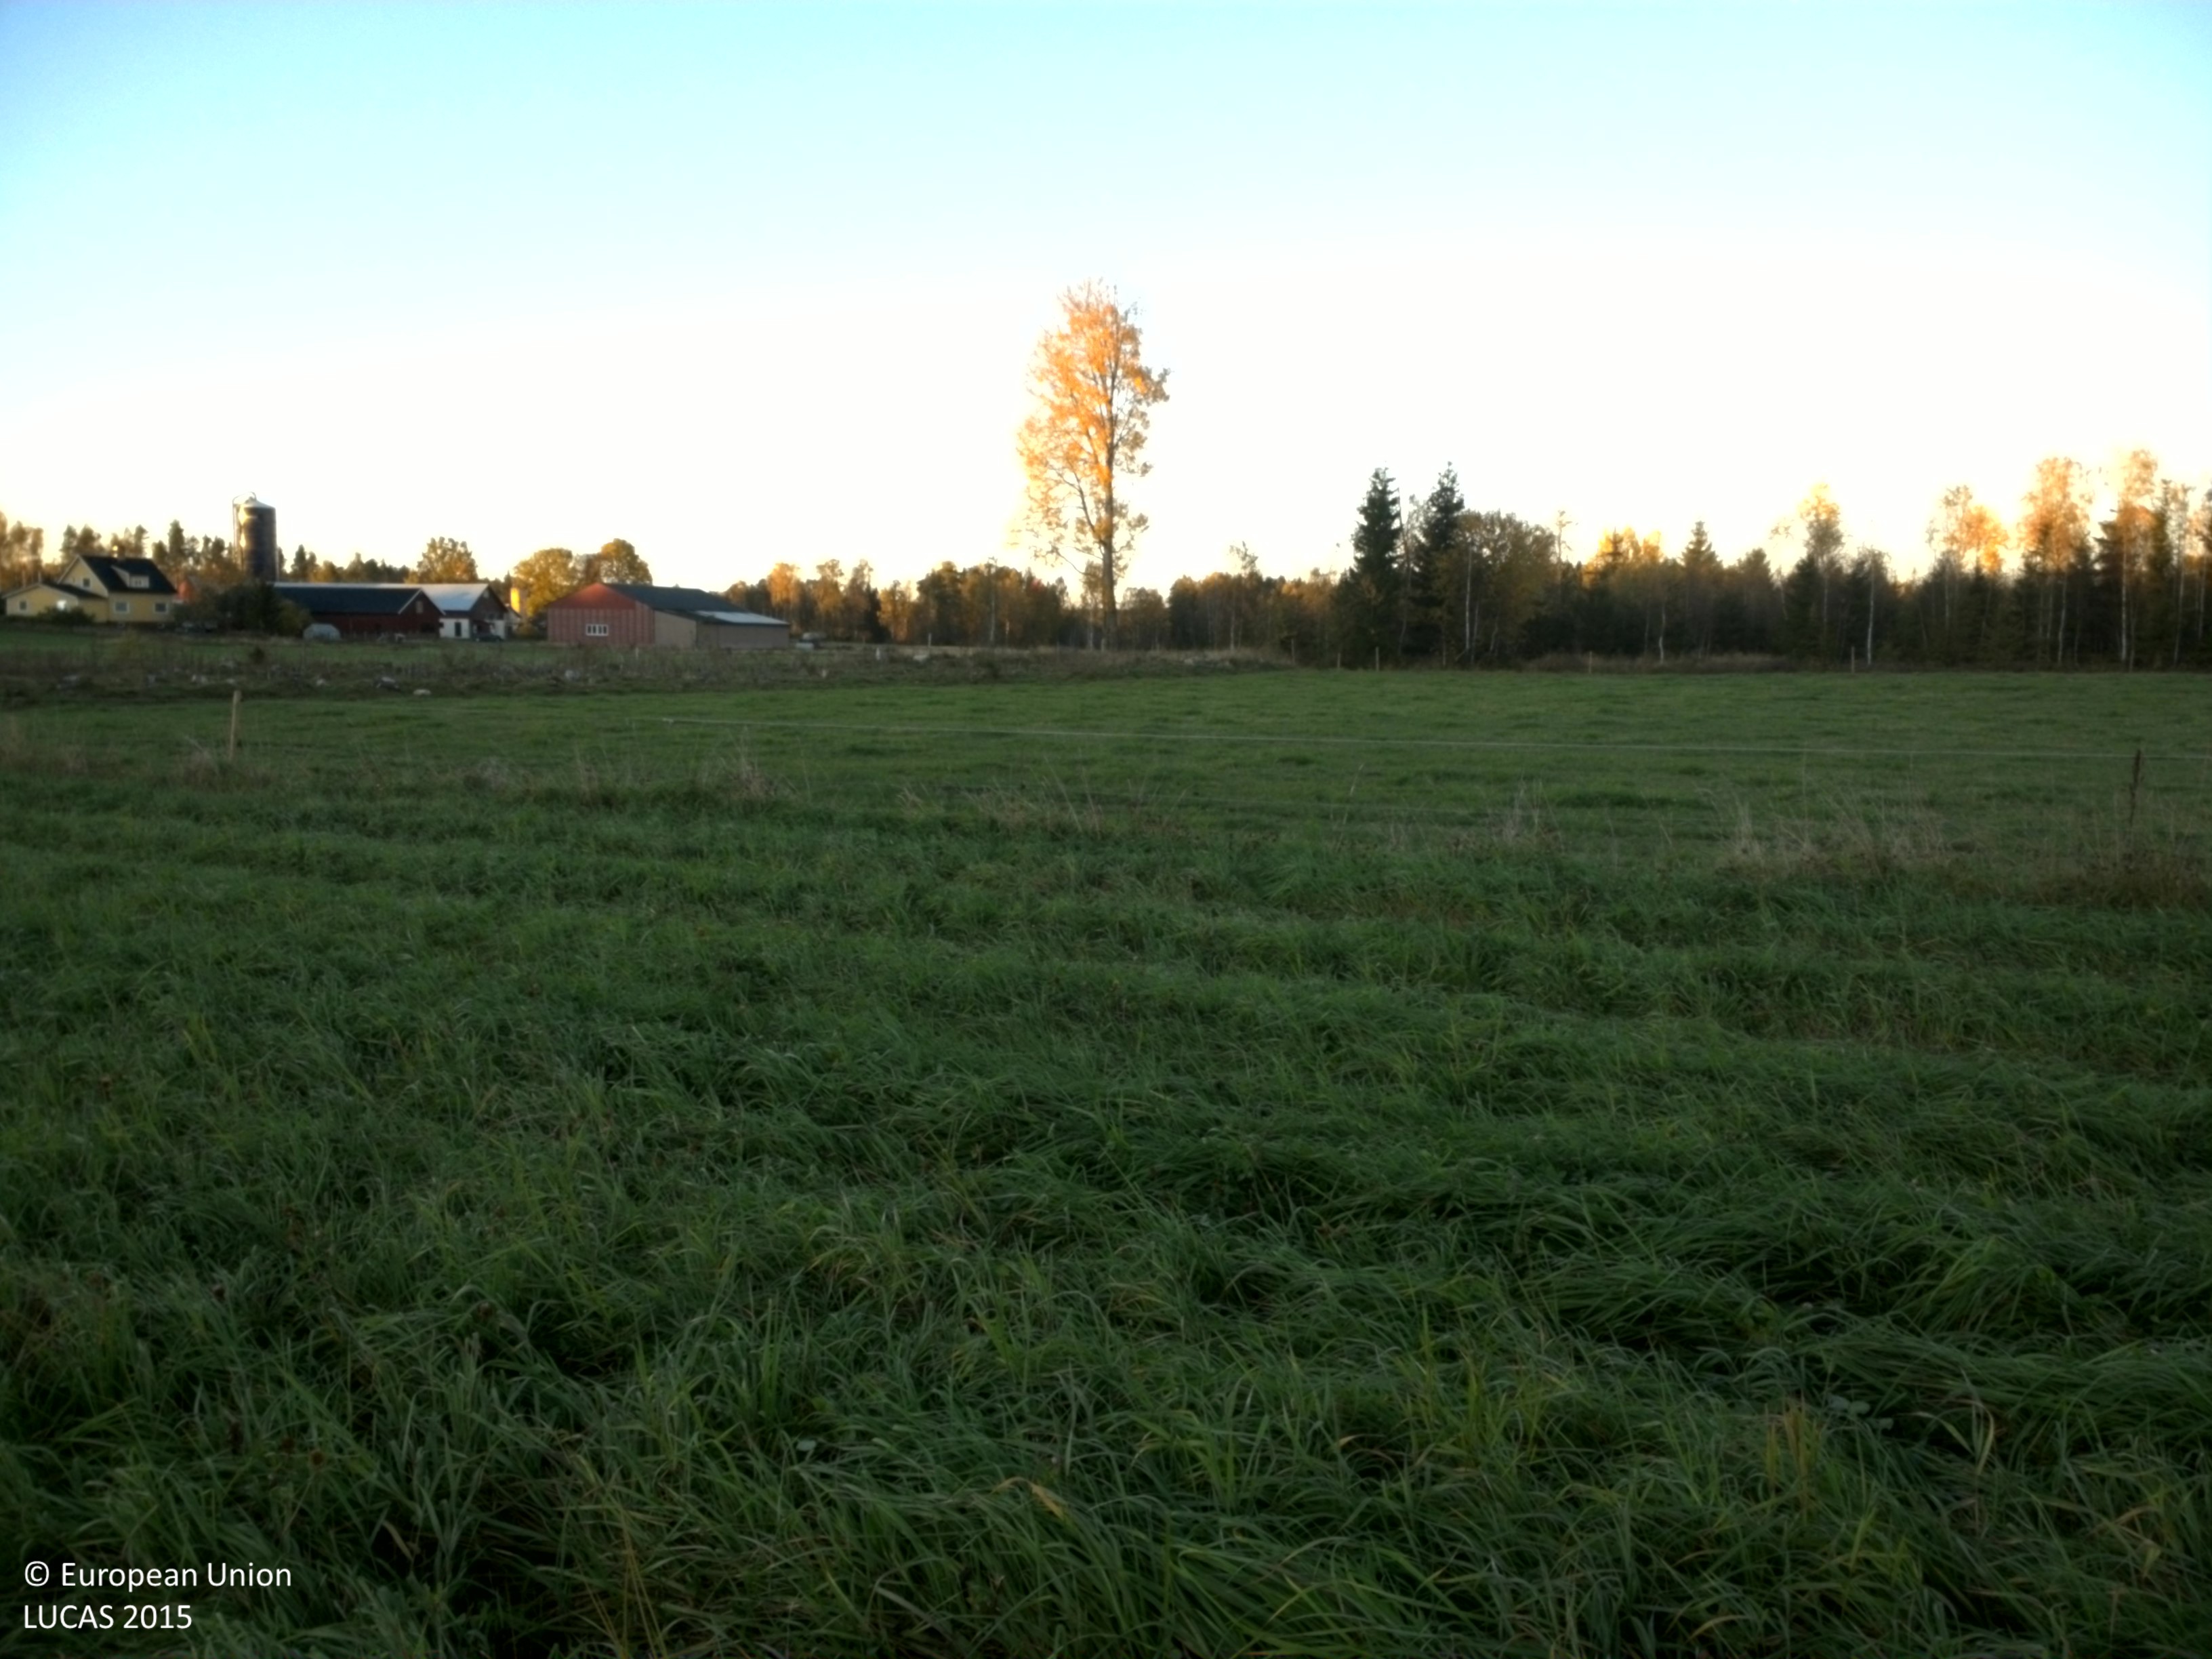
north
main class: Grassland
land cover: Grassland without tree/shrub cover
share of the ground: > 75 %
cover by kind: herbaceous plants 100 %
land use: Agriculture (excluding fallow land and kitchen gardens)
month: October
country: SE
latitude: 59.1555
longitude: 13.1232
